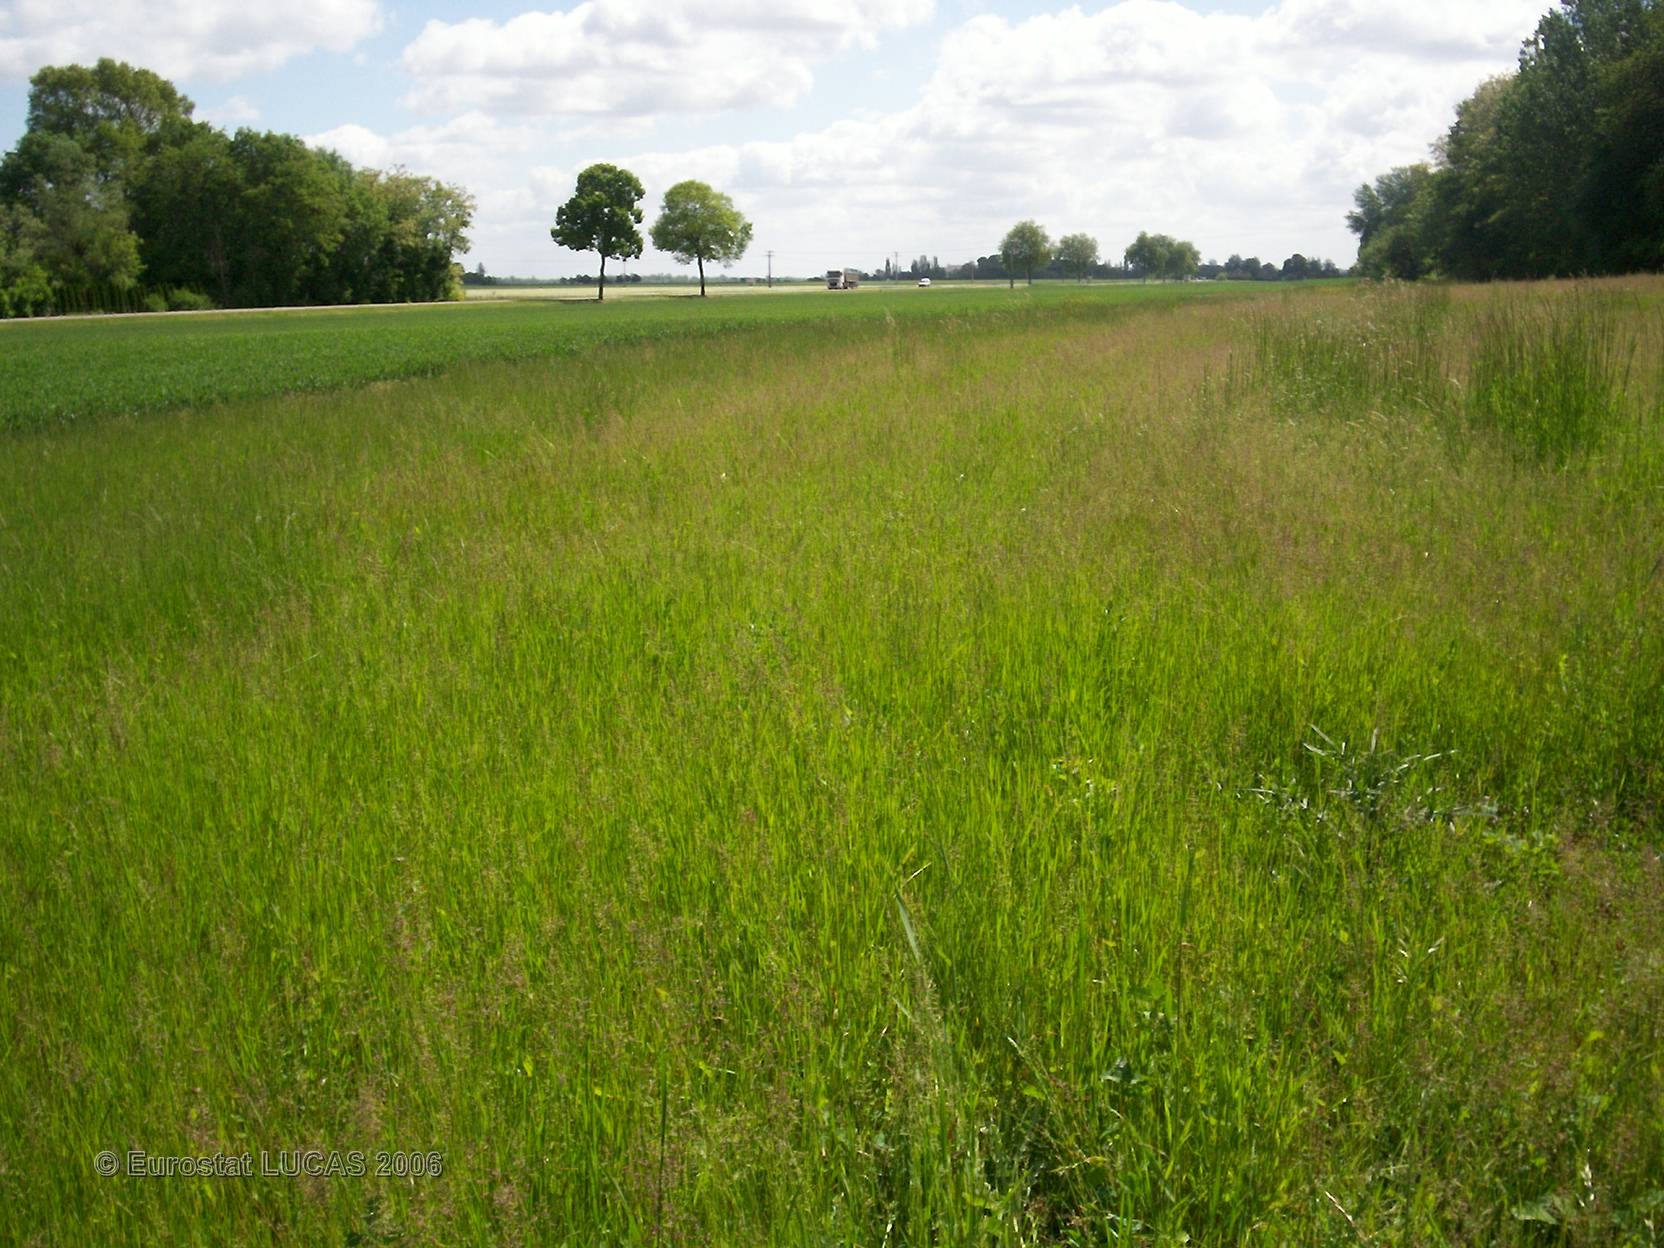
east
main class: Grassland
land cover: Grassland without tree/shrub cover
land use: Agriculture (excluding fallow land and kitchen gardens)
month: May
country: FR
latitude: 48.4261
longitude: 4.4429
